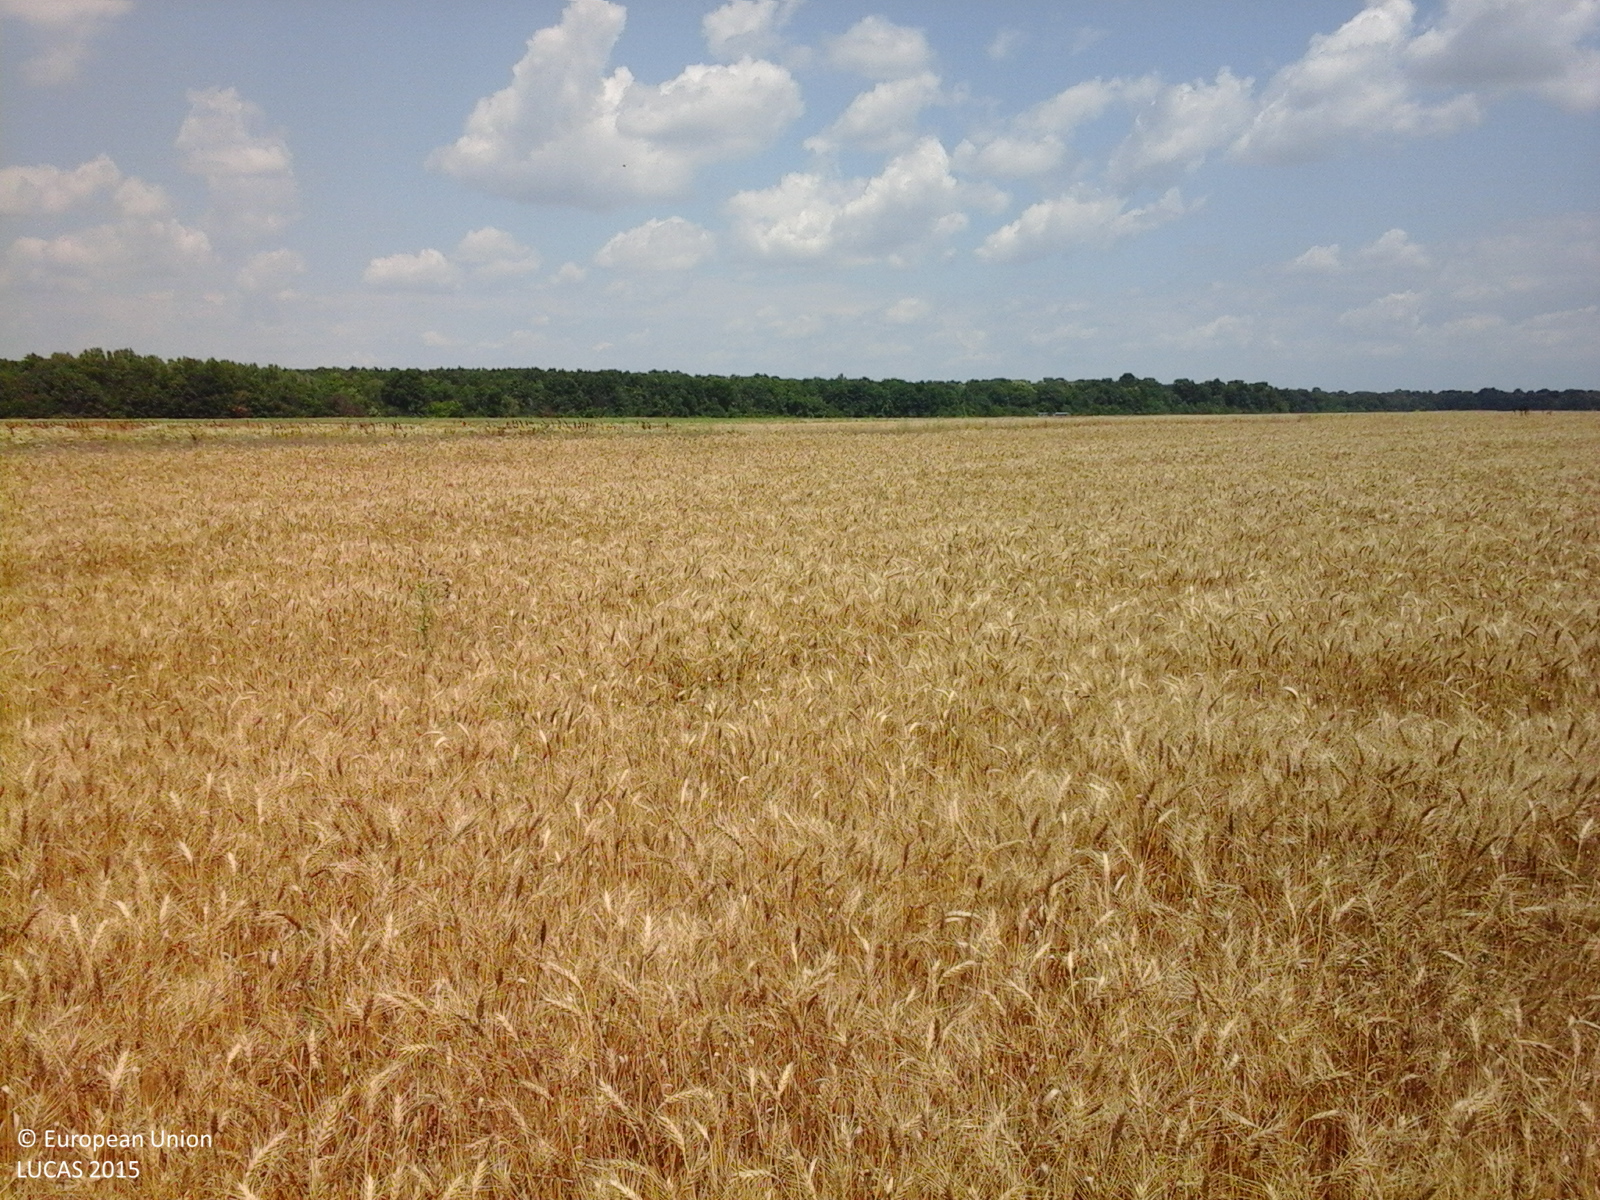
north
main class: Cropland
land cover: Common wheat
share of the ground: > 75 %
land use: Agriculture (excluding fallow land and kitchen gardens)
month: July
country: RO
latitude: 44.4405
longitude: 25.6362
